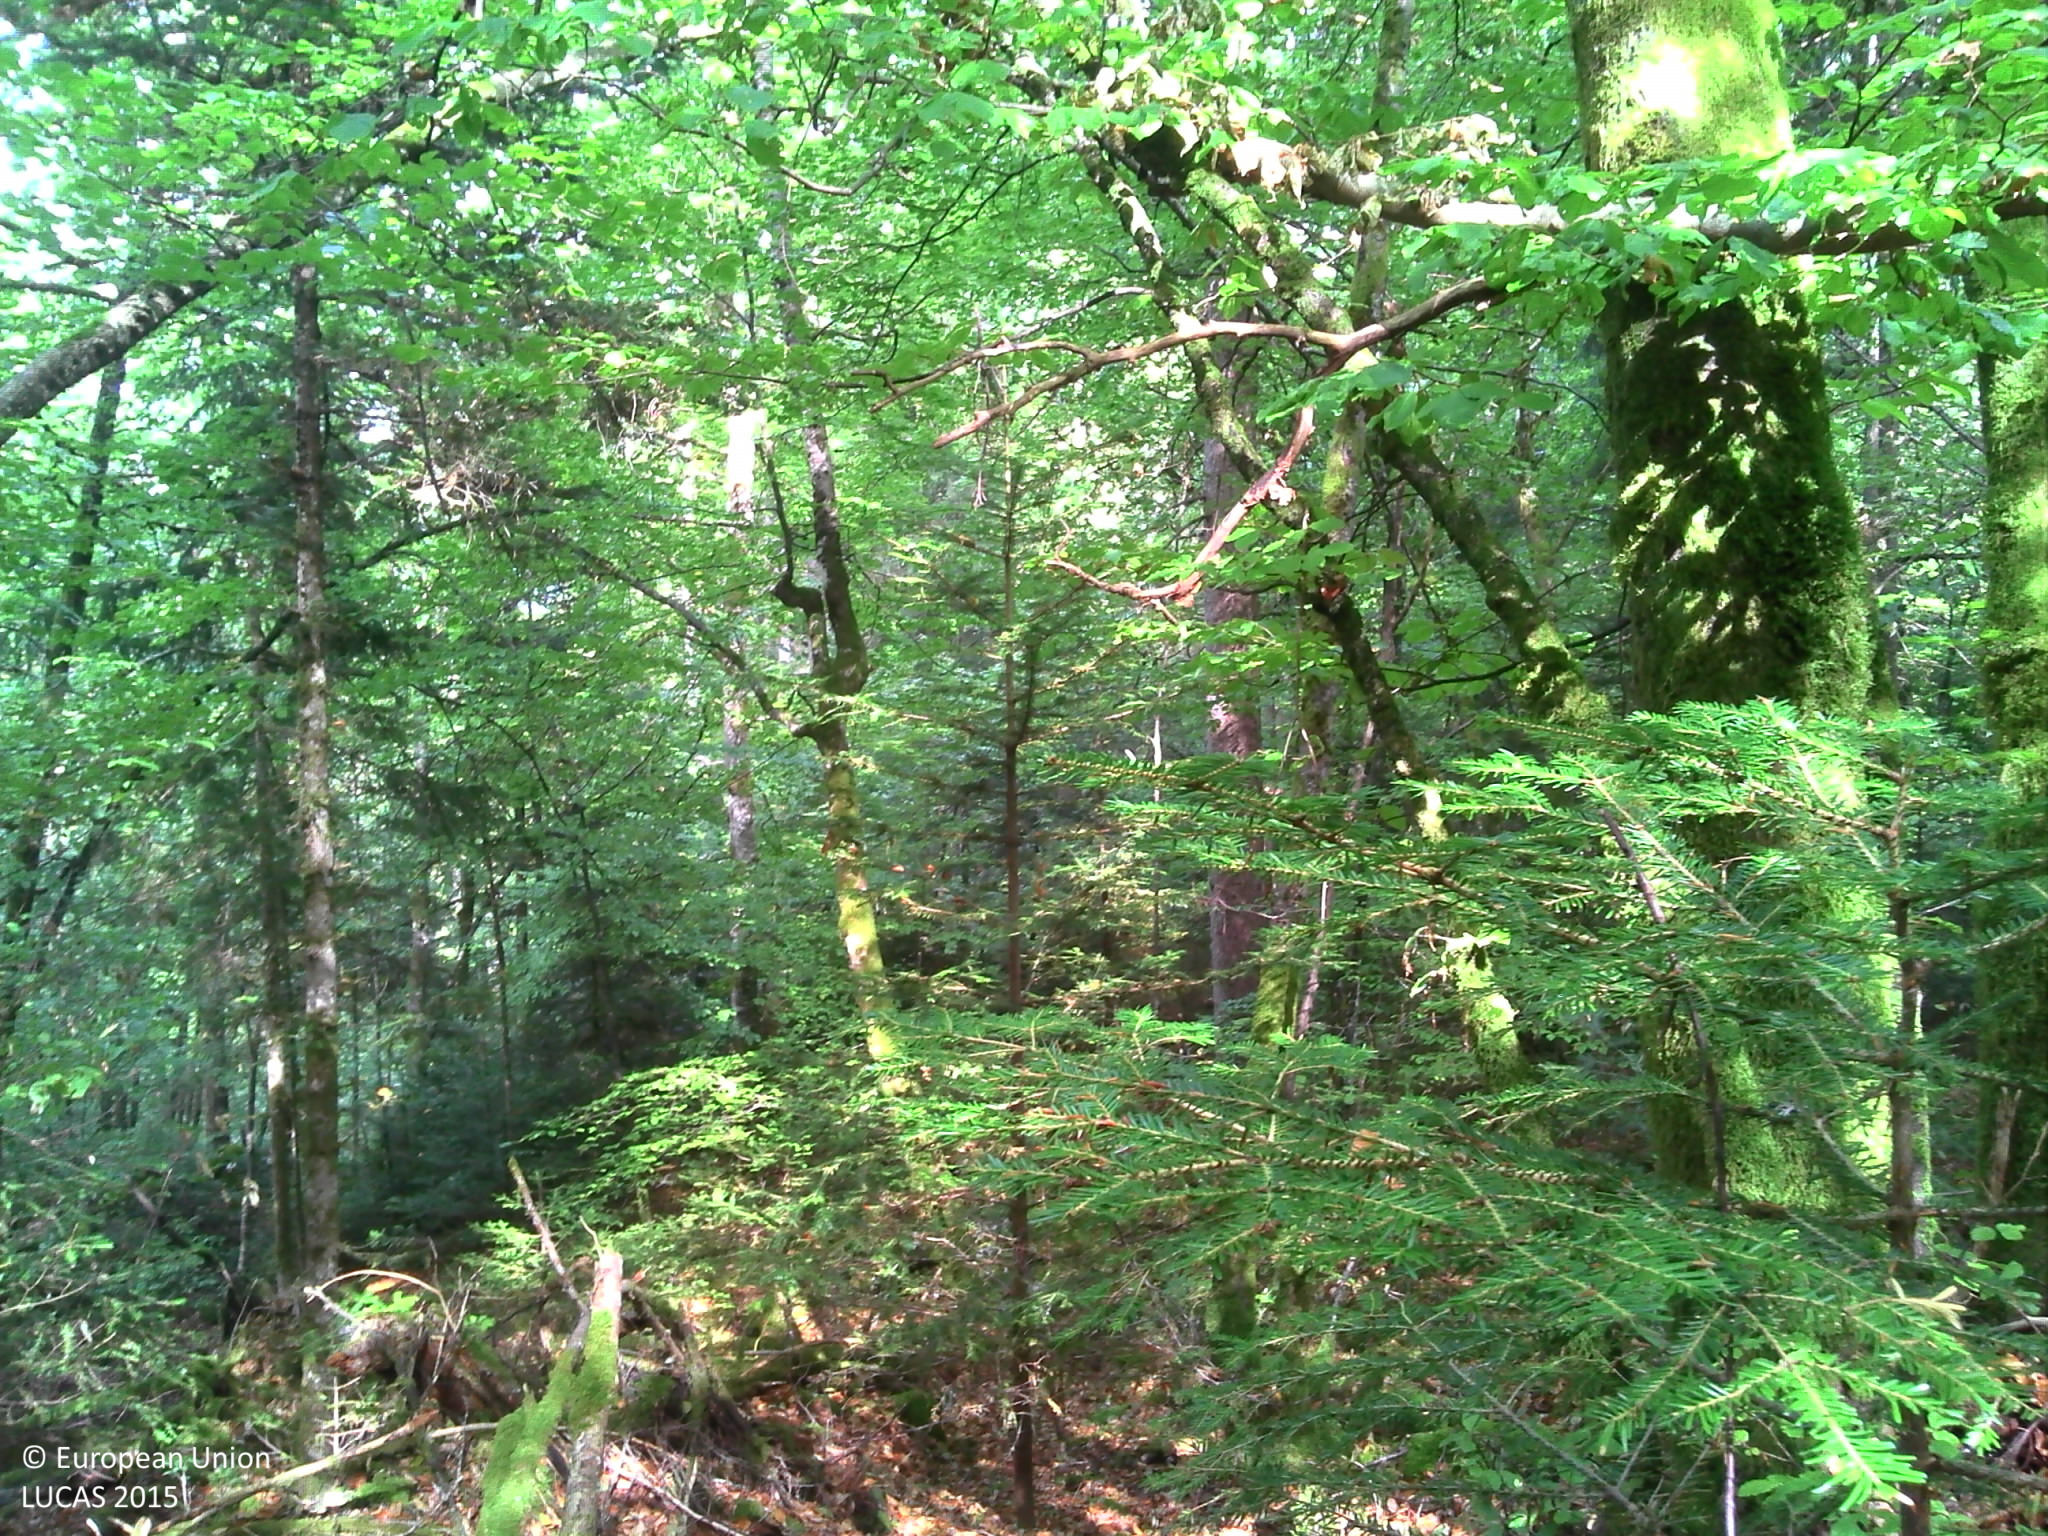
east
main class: Woodland
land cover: Broadleaved woodland
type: beech forest
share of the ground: > 75 %
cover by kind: broadleaved forest trees 65 %, coniferous forest trees 15 %, herbaceous plants 15 %, lichens and mosses 5 %
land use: Forestry
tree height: > 5 m
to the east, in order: Broadleaved woodland; Paved roads, cycling and walking lanes; Broadleaved woodland; Grassland with sparse tree/shrub cover; Tracks; Grassland with sparse tree/shrub cover; Tracks; Grassland with sparse tree/shrub cover; Artificial constructions in urban areas; Spontaneously vegetated surfaces; Fences; Grassland with sparse tree/shrub cover; Grassland without tree/shrub cover
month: July
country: FR
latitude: 46.0570
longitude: 6.4233
